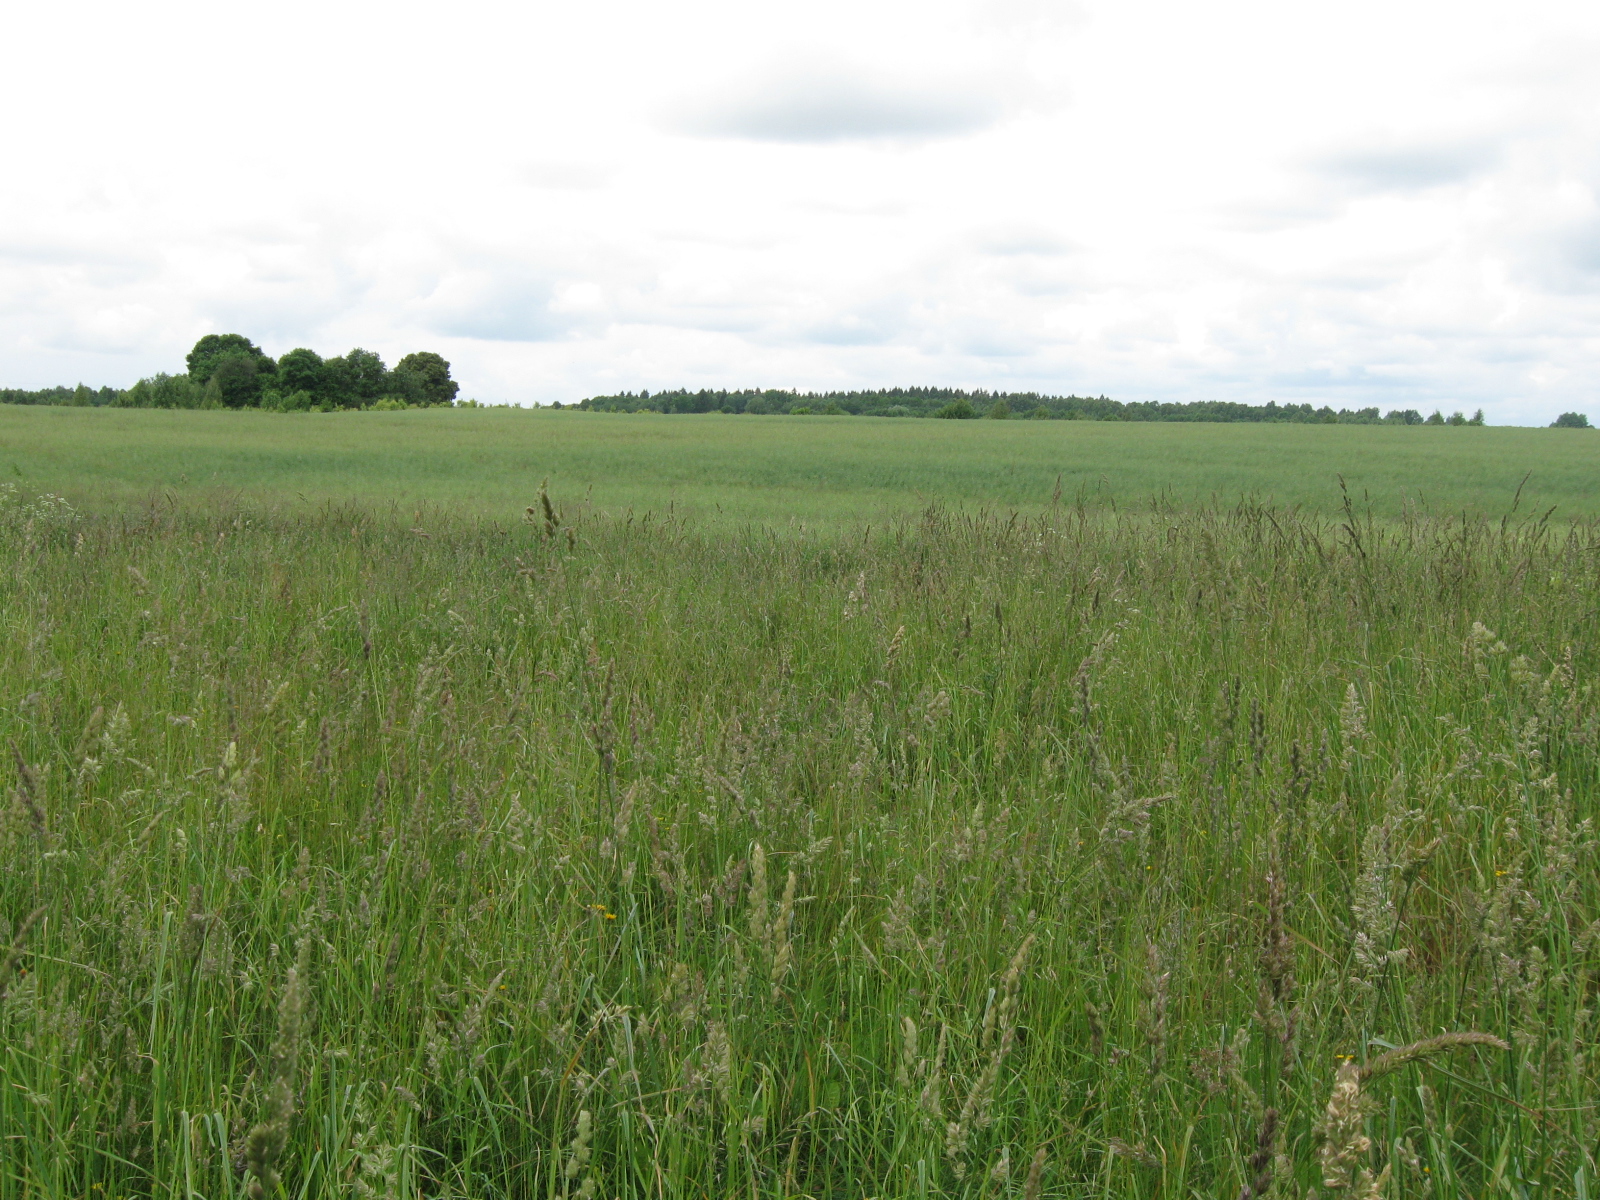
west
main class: Grassland
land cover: Grassland without tree/shrub cover
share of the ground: > 75 %
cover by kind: herbaceous plants 100 %
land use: Agriculture (excluding fallow land and kitchen gardens)
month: June
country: LT
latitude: 54.9288
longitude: 24.5697
